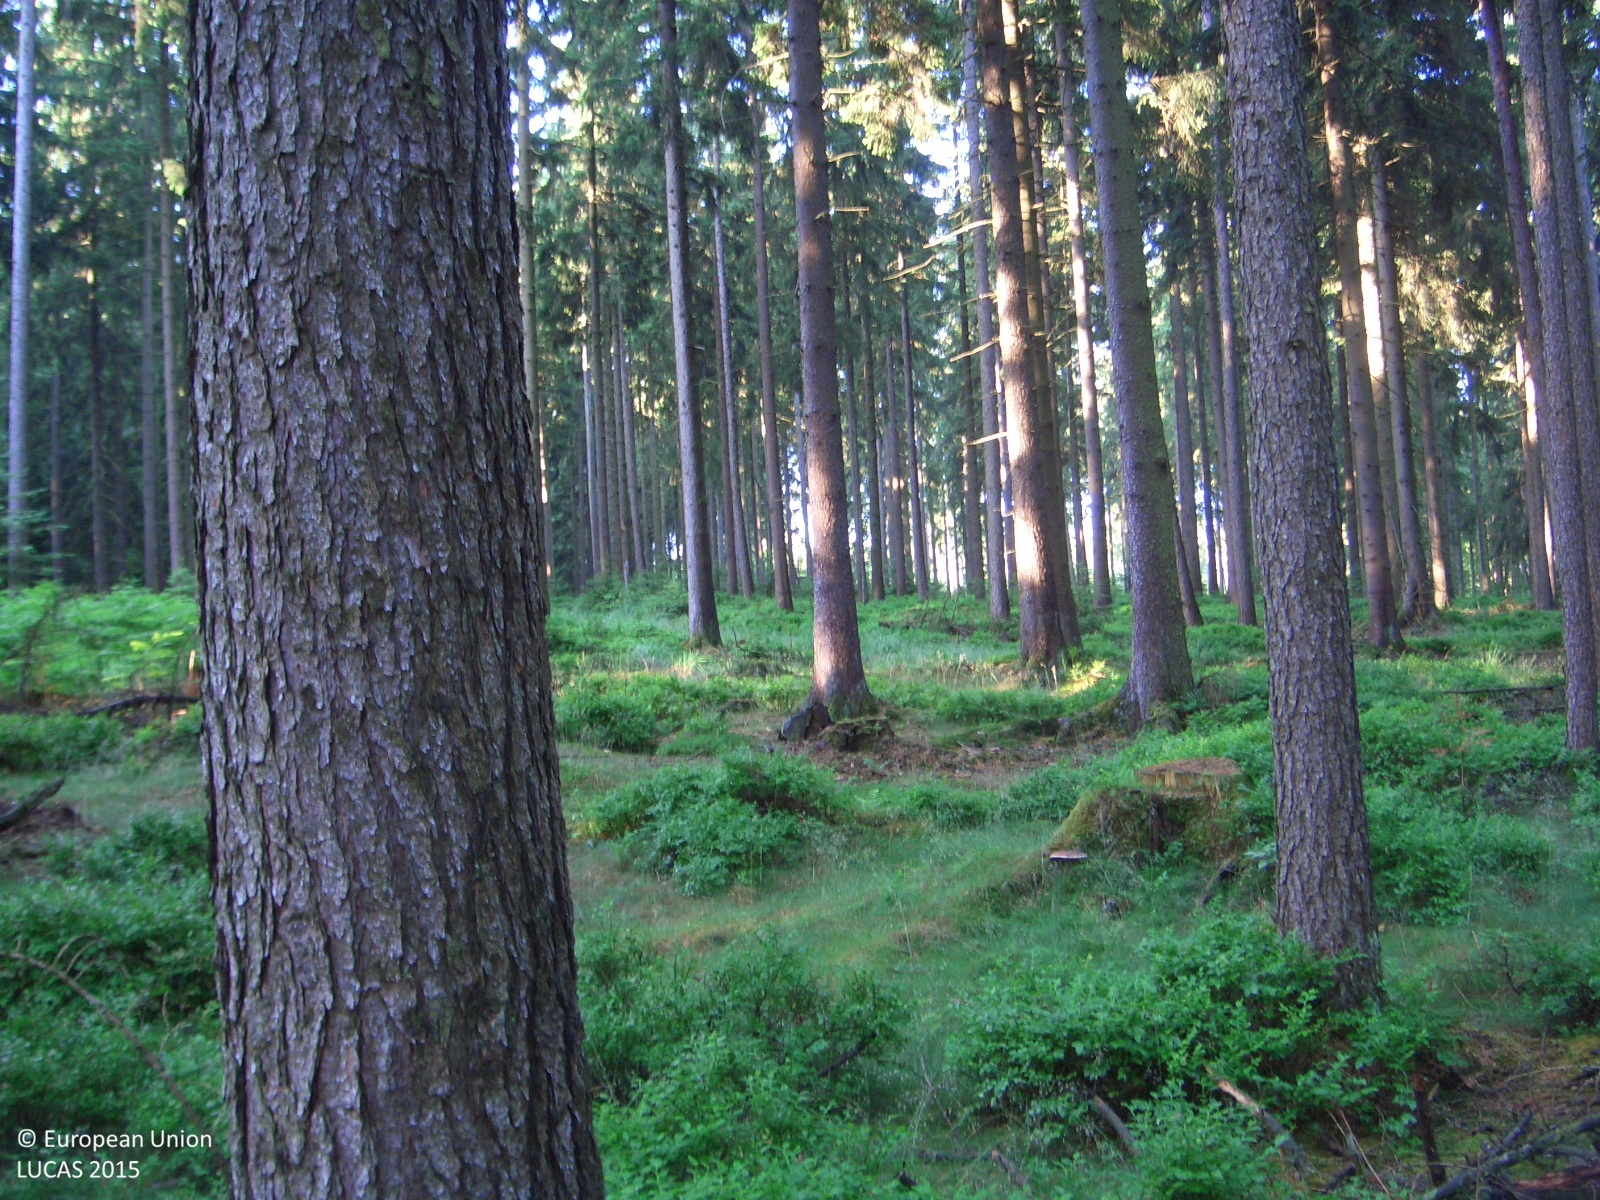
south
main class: Woodland
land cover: Spruce dominated coniferous woodland
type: hemiboreal forest and nemoral coniferous forest and mixed broadleaved-coniferous forest
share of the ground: 50 - 75 %
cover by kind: coniferous forest trees 80 %, herbaceous plants 20 %
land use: Forestry
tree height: > 5 m
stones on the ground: 25 - 50 %
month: July
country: DE
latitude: 50.6626
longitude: 6.2503
